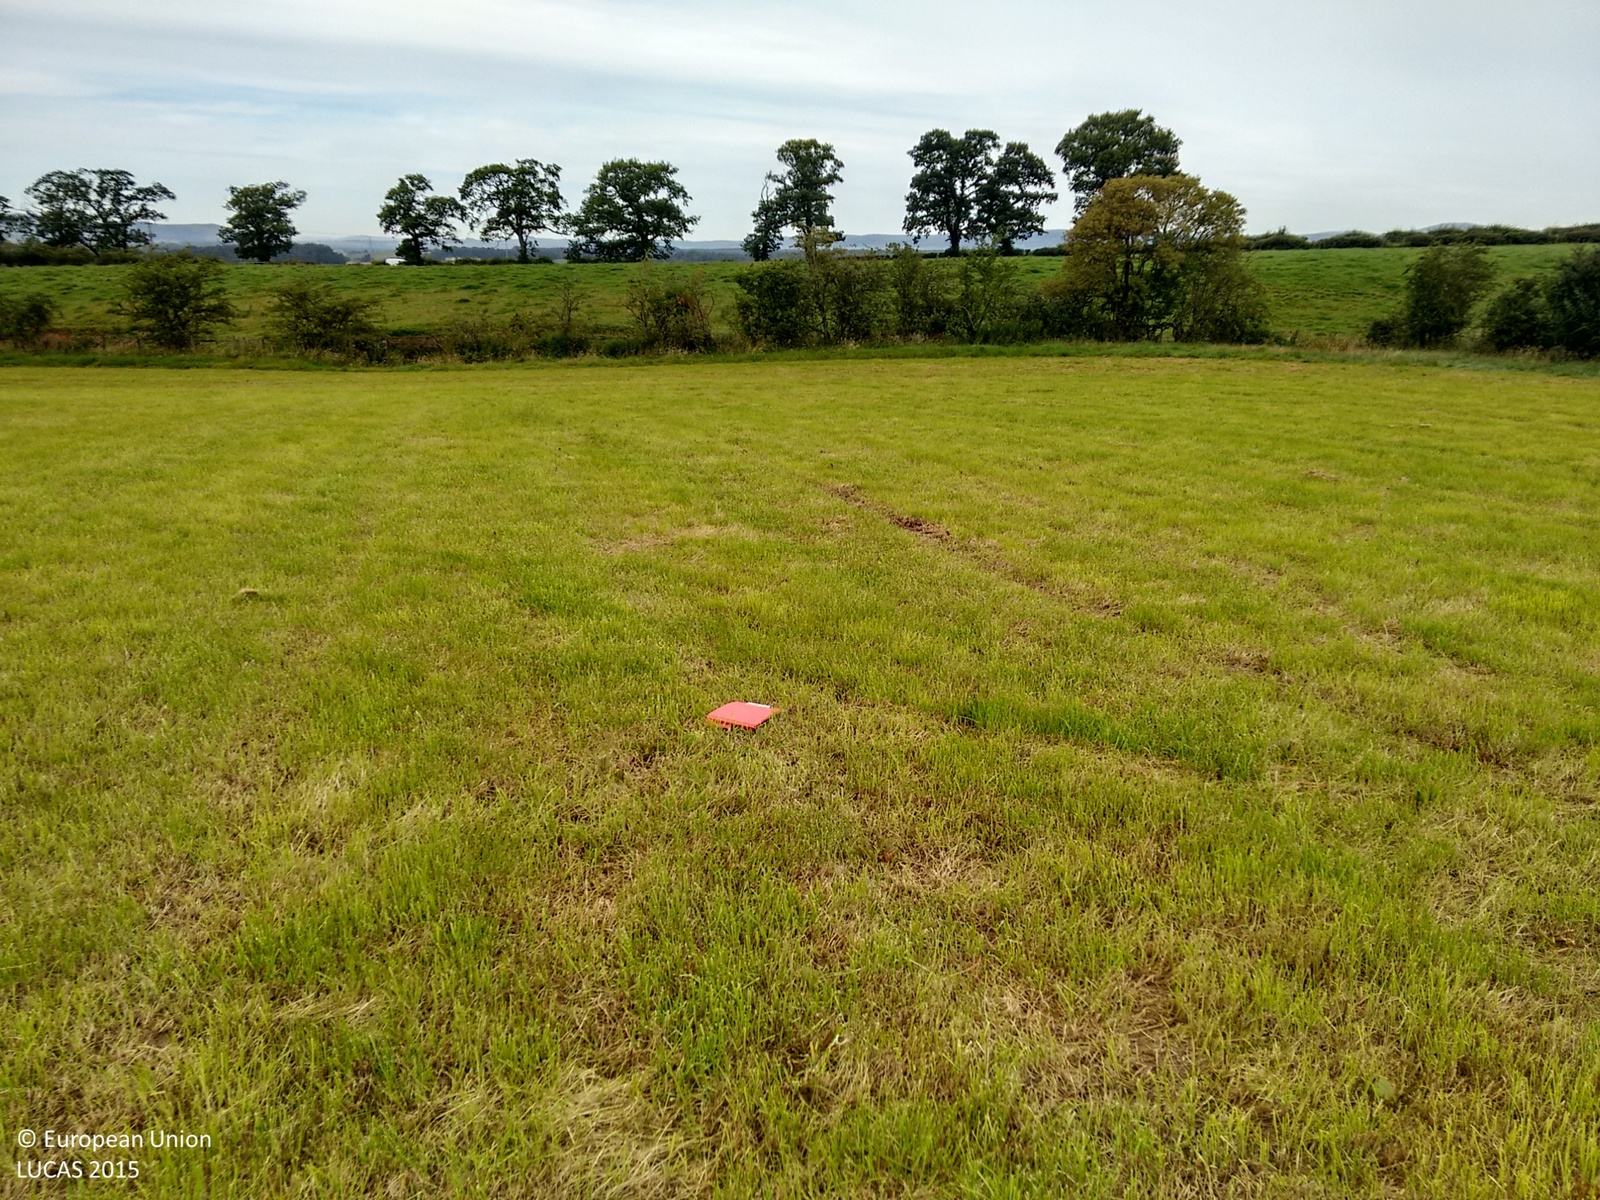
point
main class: Grassland
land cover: Grassland without tree/shrub cover
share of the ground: > 75 %
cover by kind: herbaceous plants 80 %, unconsolidated bare surface 20 %
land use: Agriculture (excluding fallow land and kitchen gardens)
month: August
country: GB
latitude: 55.1553
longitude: -3.3702
